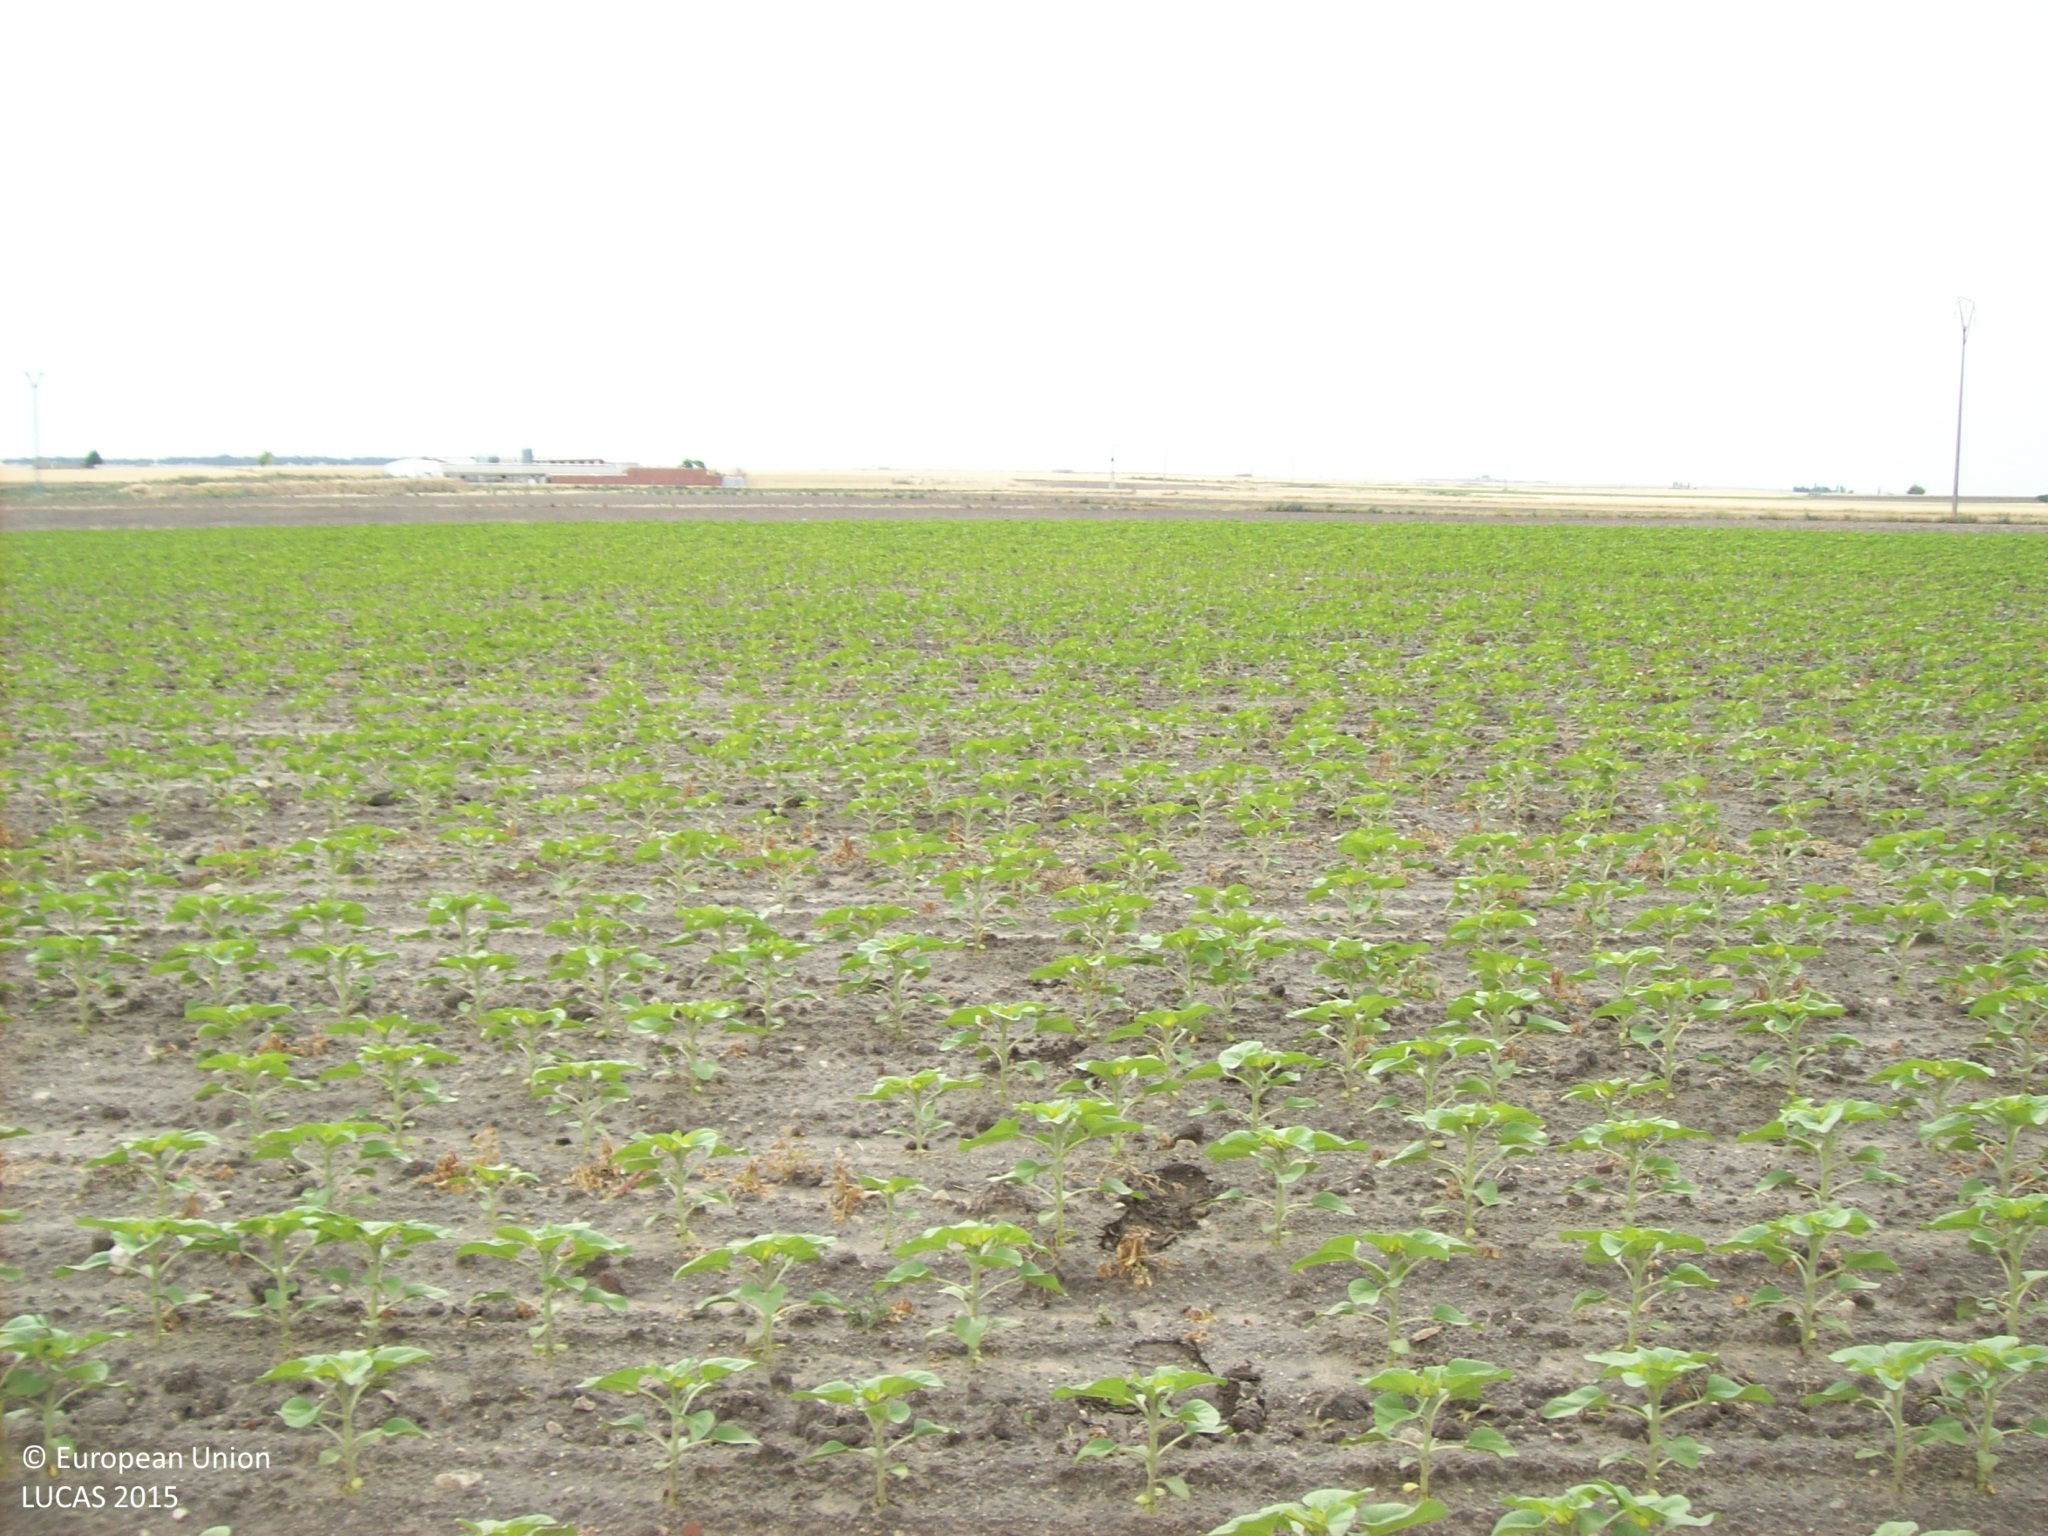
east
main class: Cropland
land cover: Sunflower
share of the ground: 50 - 75 %
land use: Agriculture (excluding fallow land and kitchen gardens)
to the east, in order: Sunflower; Grass margins; Other bare soil; Grass margins; Other bare soil; Electric lines; Other bare soil; Grass margins; Other bare soil
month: June
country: ES
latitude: 40.9505
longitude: -4.9489
